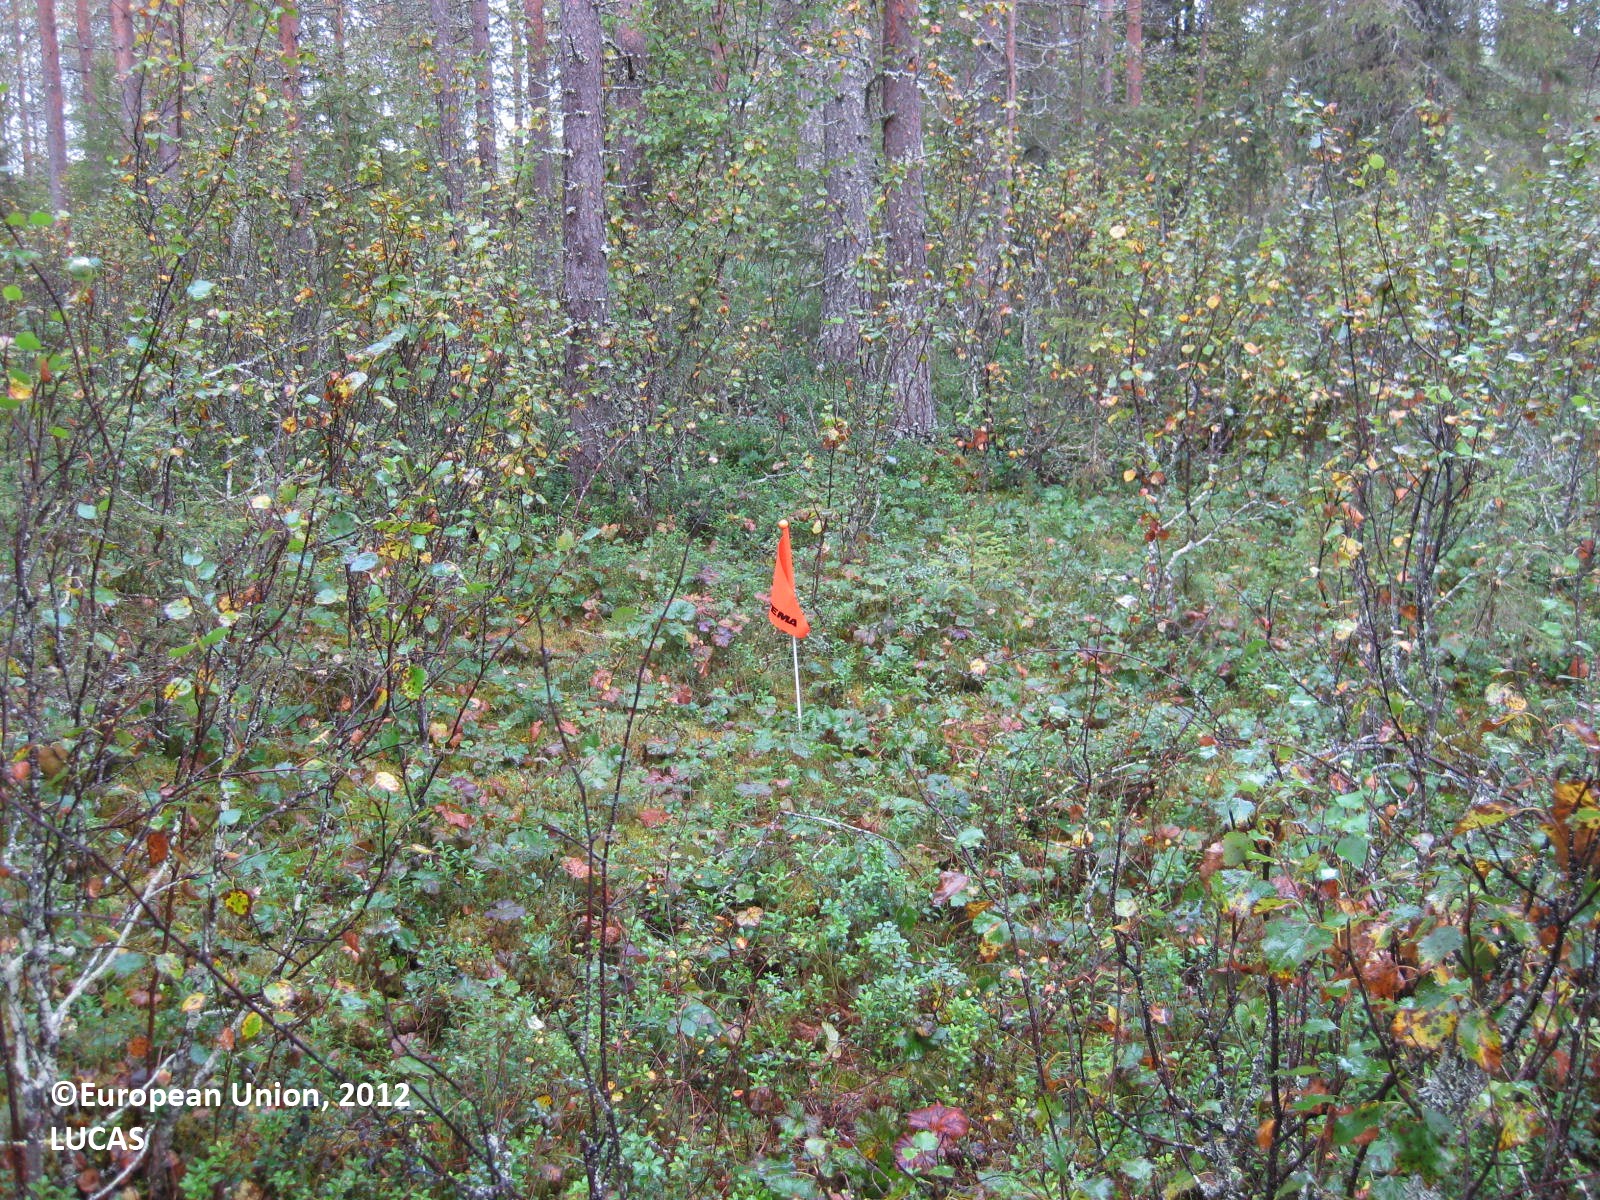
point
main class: Woodland
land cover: Pine dominated mixed woodland
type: boreal forest
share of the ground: 50 - 75 %
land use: Forestry
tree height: > 5 m
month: August
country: FI
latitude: 66.0792
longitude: 28.8405
